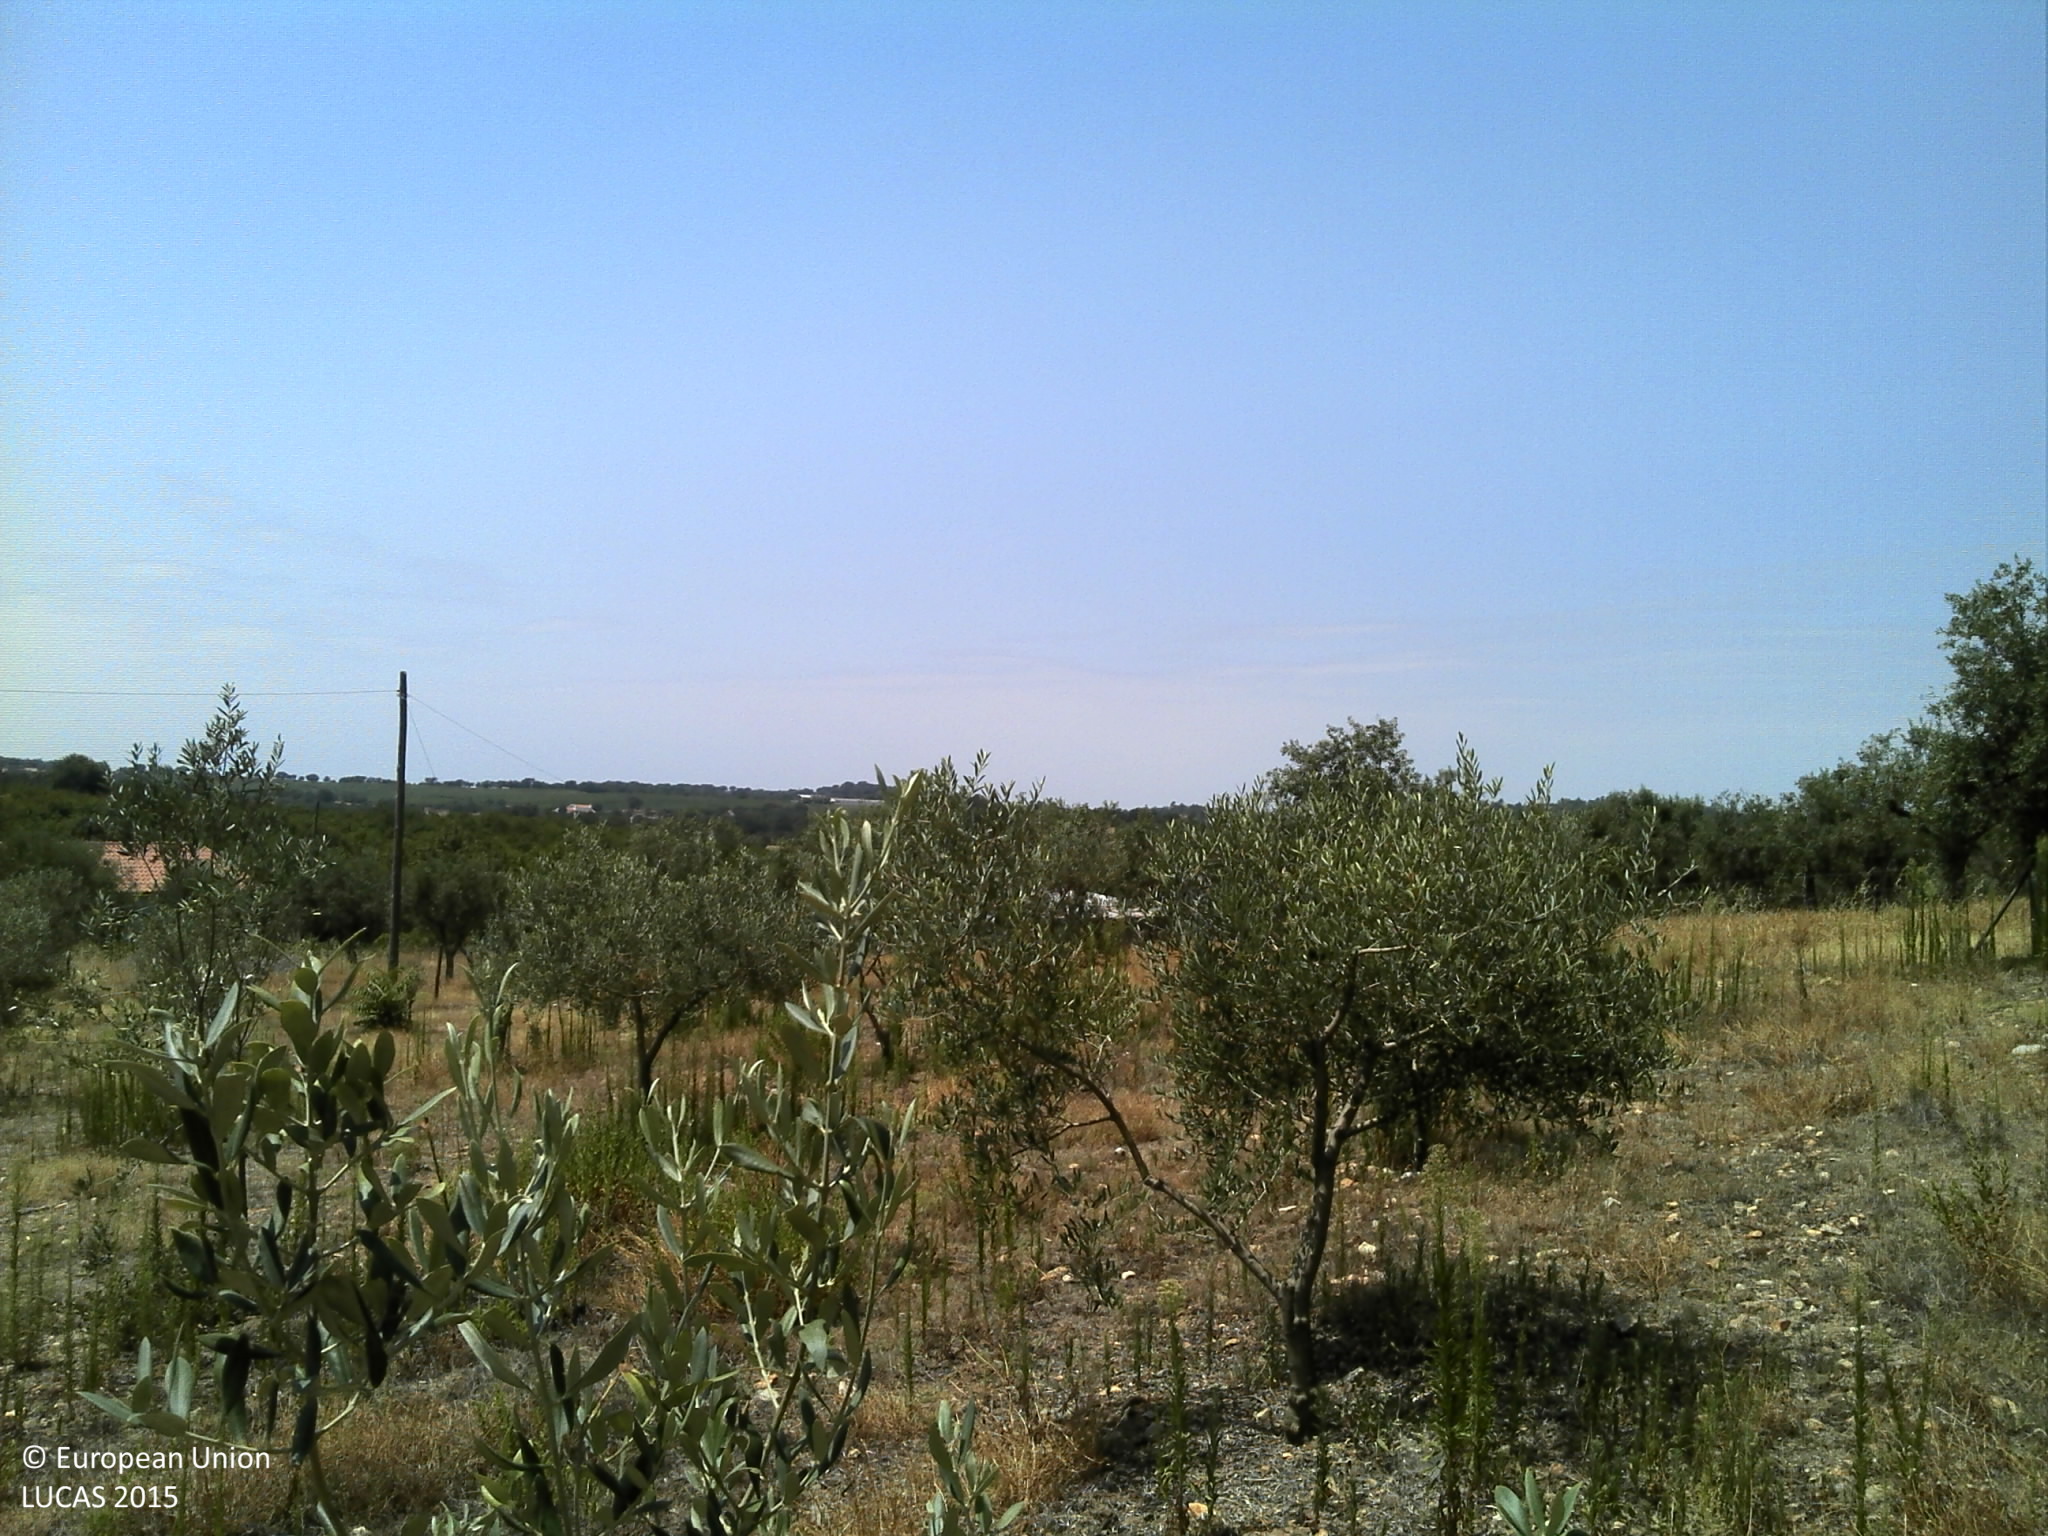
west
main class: Cropland
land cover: Olive groves
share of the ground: 10 - 25 %
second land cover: Grassland without tree/shrub cover
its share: 10 - 25 %
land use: Agriculture (excluding fallow land and kitchen gardens)
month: August
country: PT
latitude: 39.2767
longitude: -7.3697
